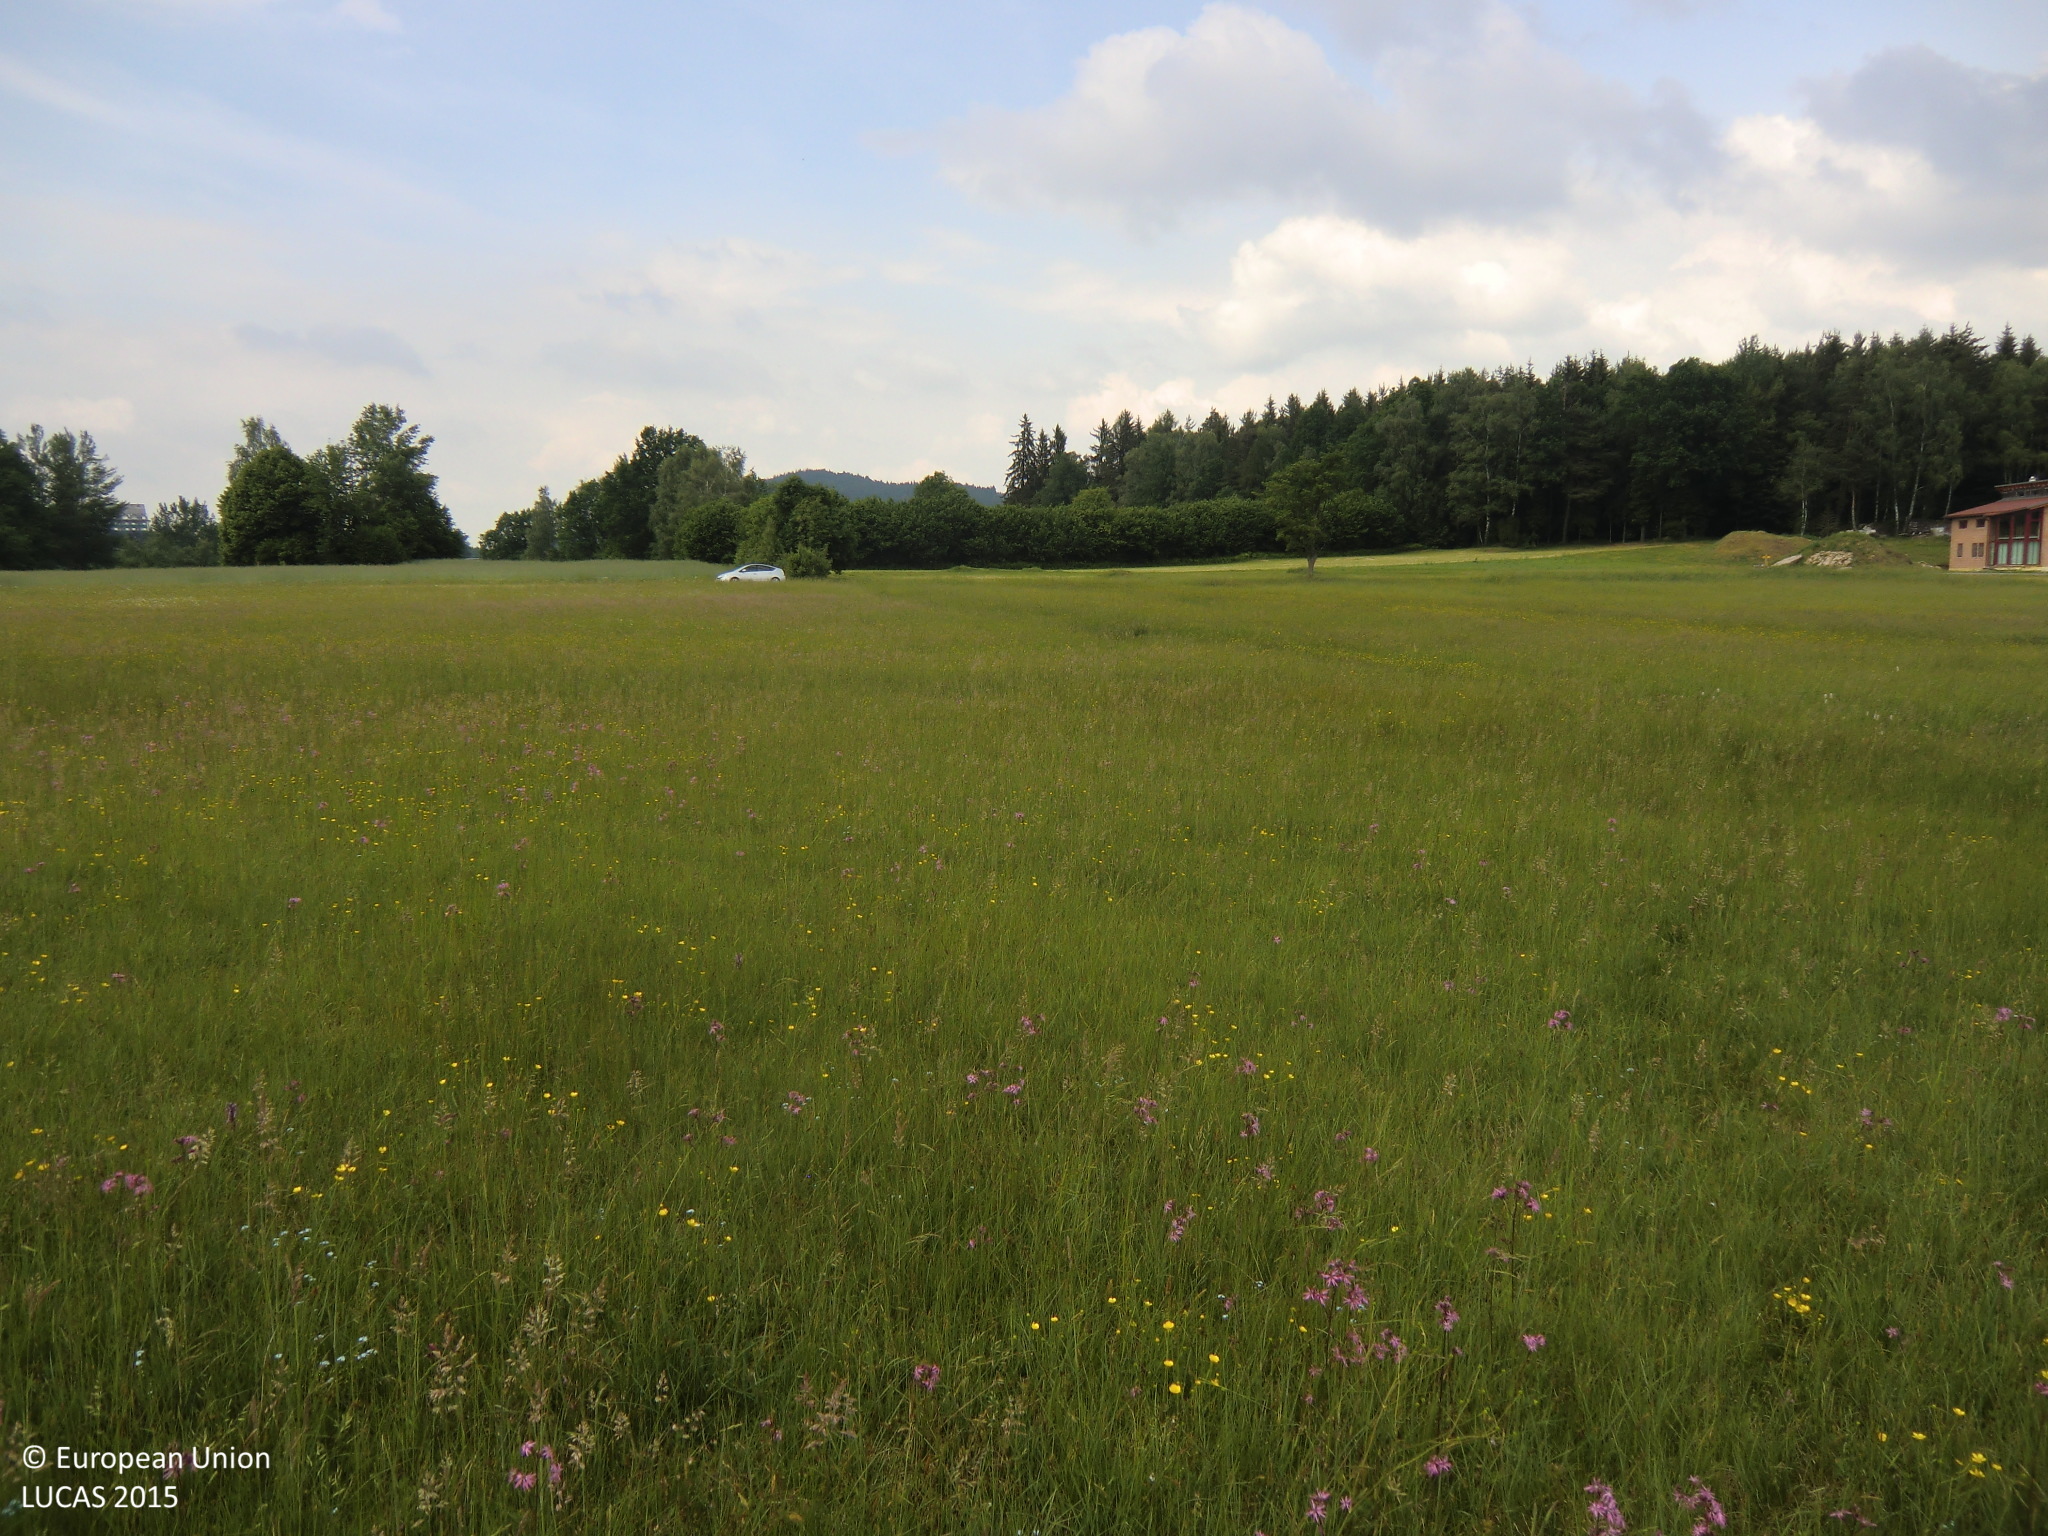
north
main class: Grassland
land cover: Grassland without tree/shrub cover
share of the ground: > 75 %
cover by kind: herbaceous plants 100 %
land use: Agriculture (excluding fallow land and kitchen gardens)
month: June
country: AT
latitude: 48.6959
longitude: 14.7973
